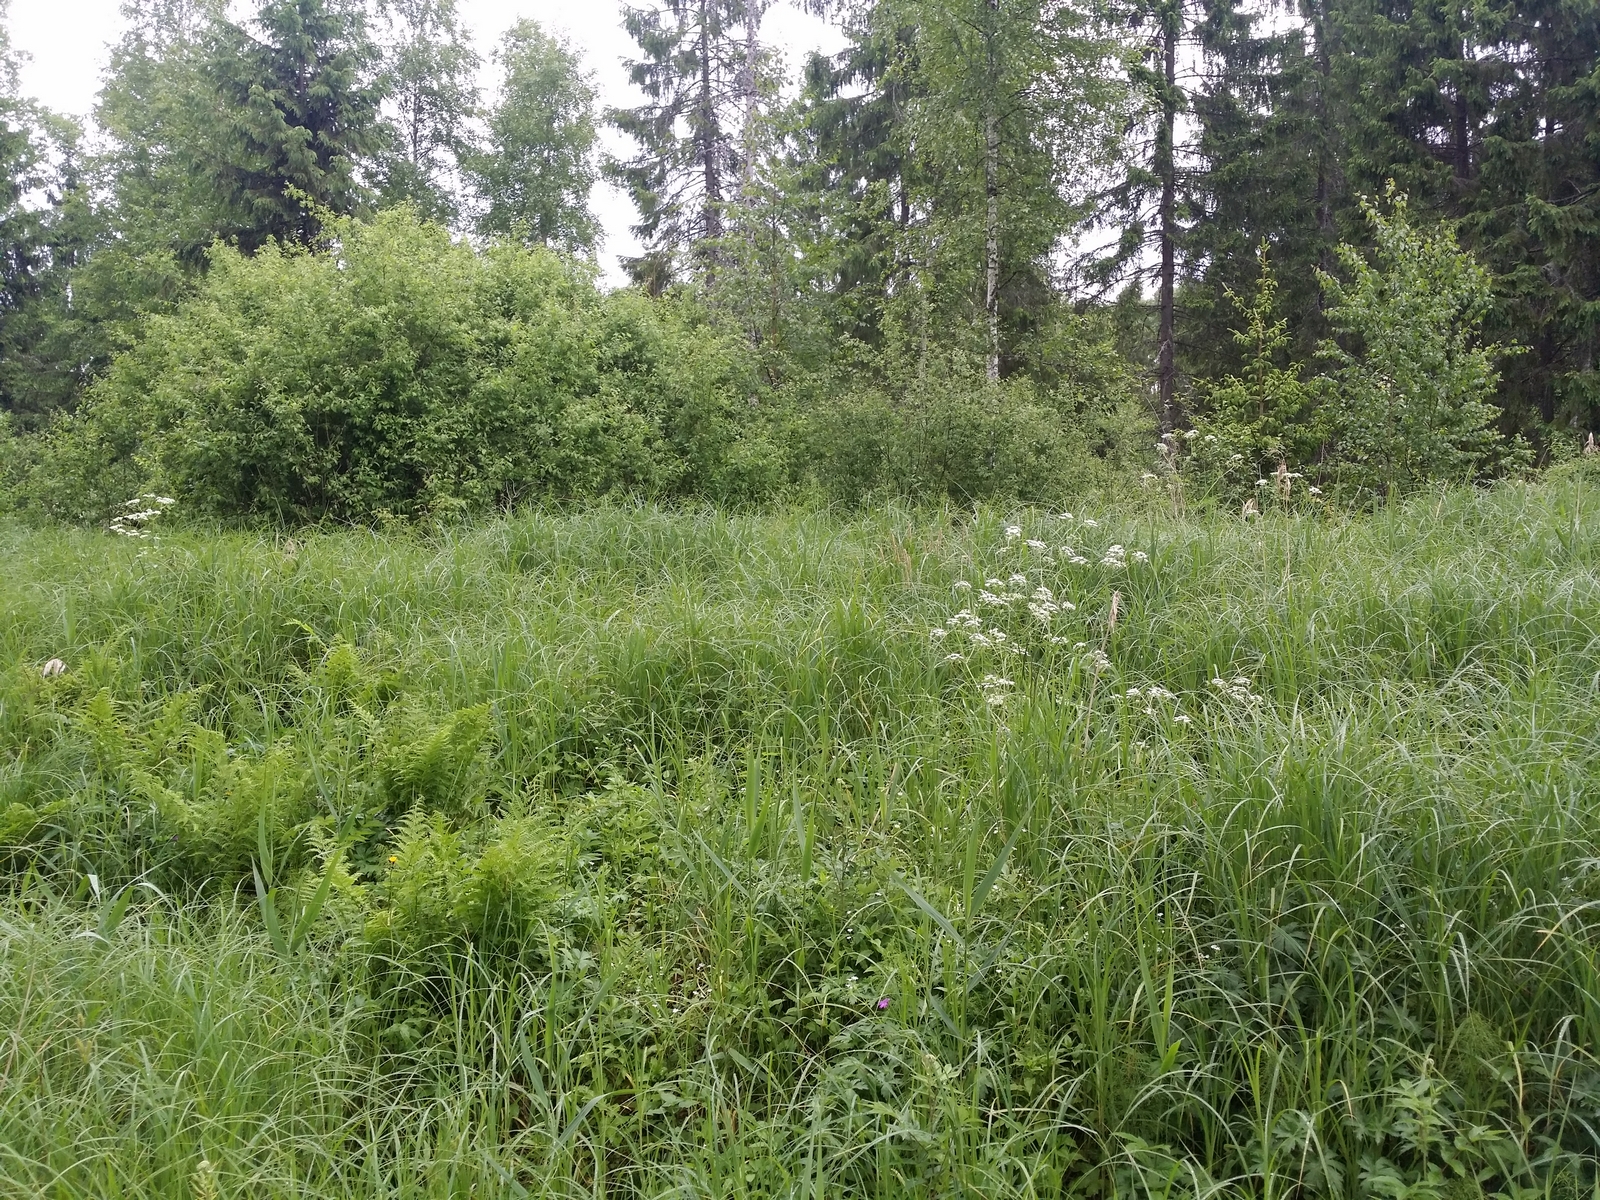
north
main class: Grassland
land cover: Spontaneously vegetated surfaces
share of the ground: > 75 %
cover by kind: herbaceous plants 95 %, shrubs 5 %
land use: Forestry
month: June
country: LV
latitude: 57.5175
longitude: 26.5211
